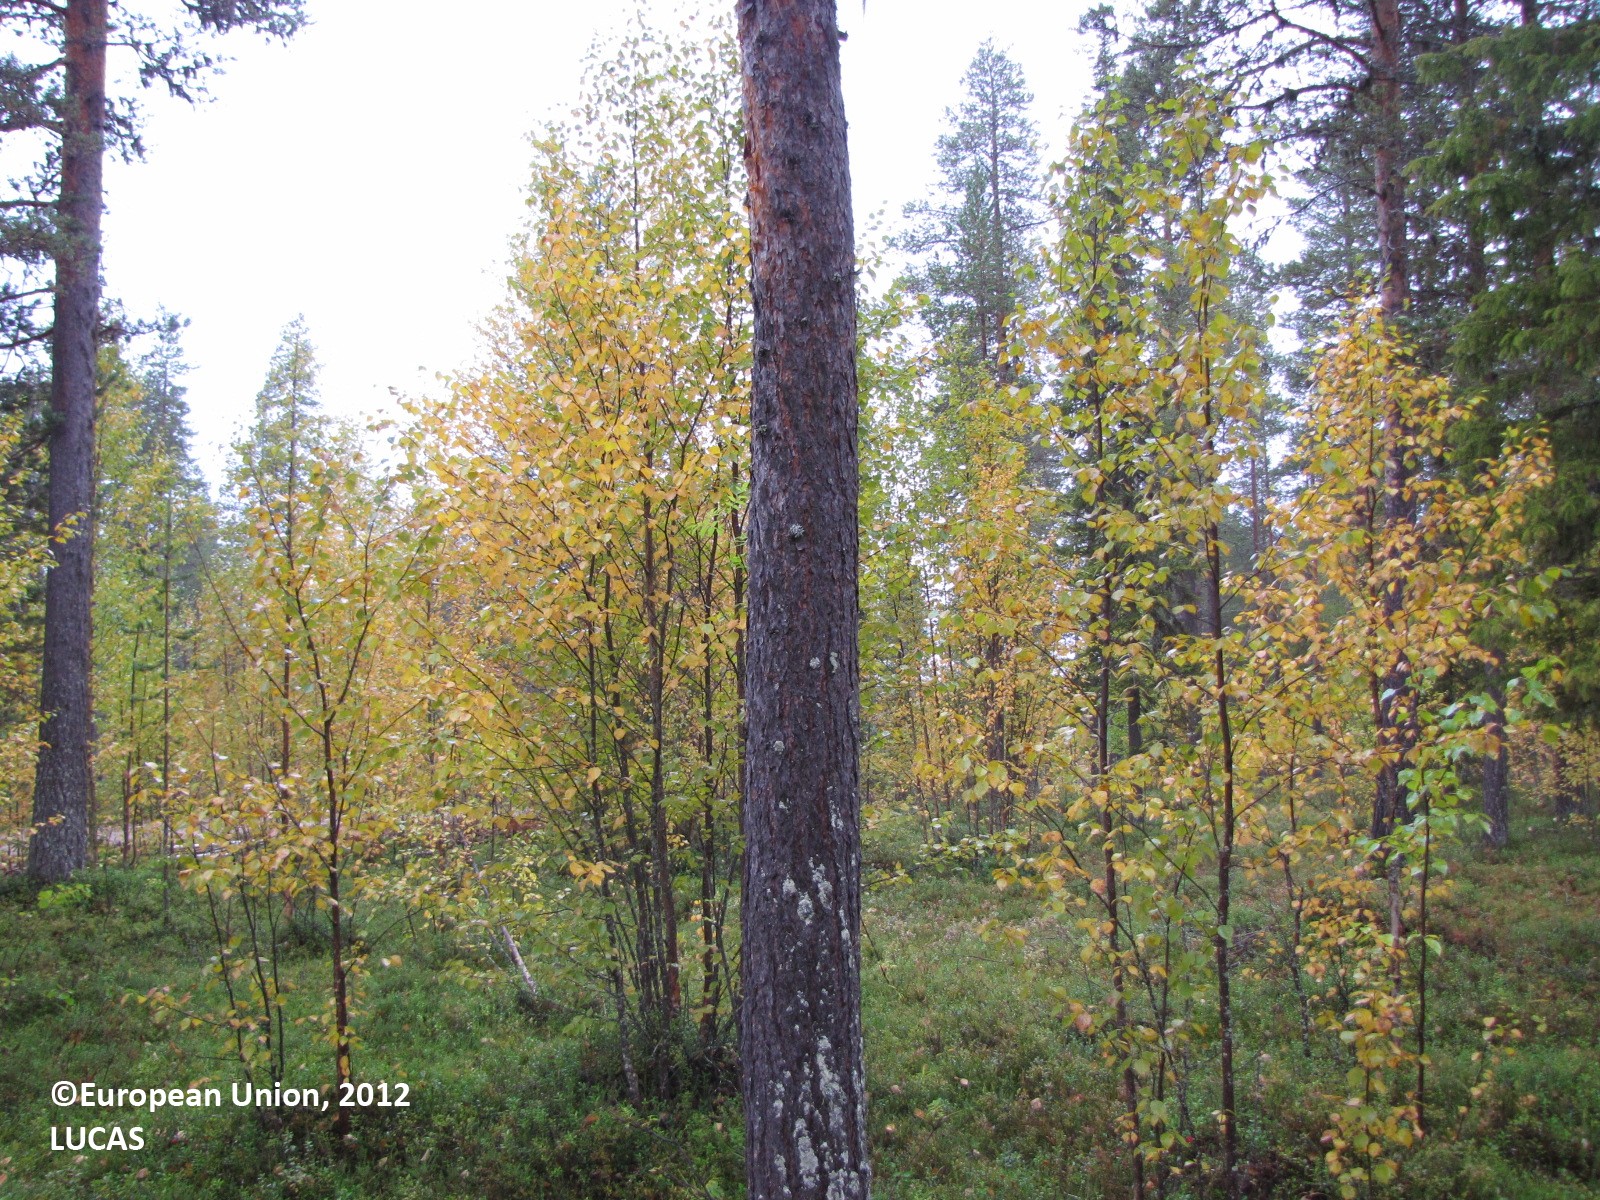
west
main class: Woodland
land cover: Pine dominated mixed woodland
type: boreal forest
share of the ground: 25 - 50 %
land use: Forestry
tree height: > 5 m
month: September
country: FI
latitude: 67.6149
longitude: 25.2668
